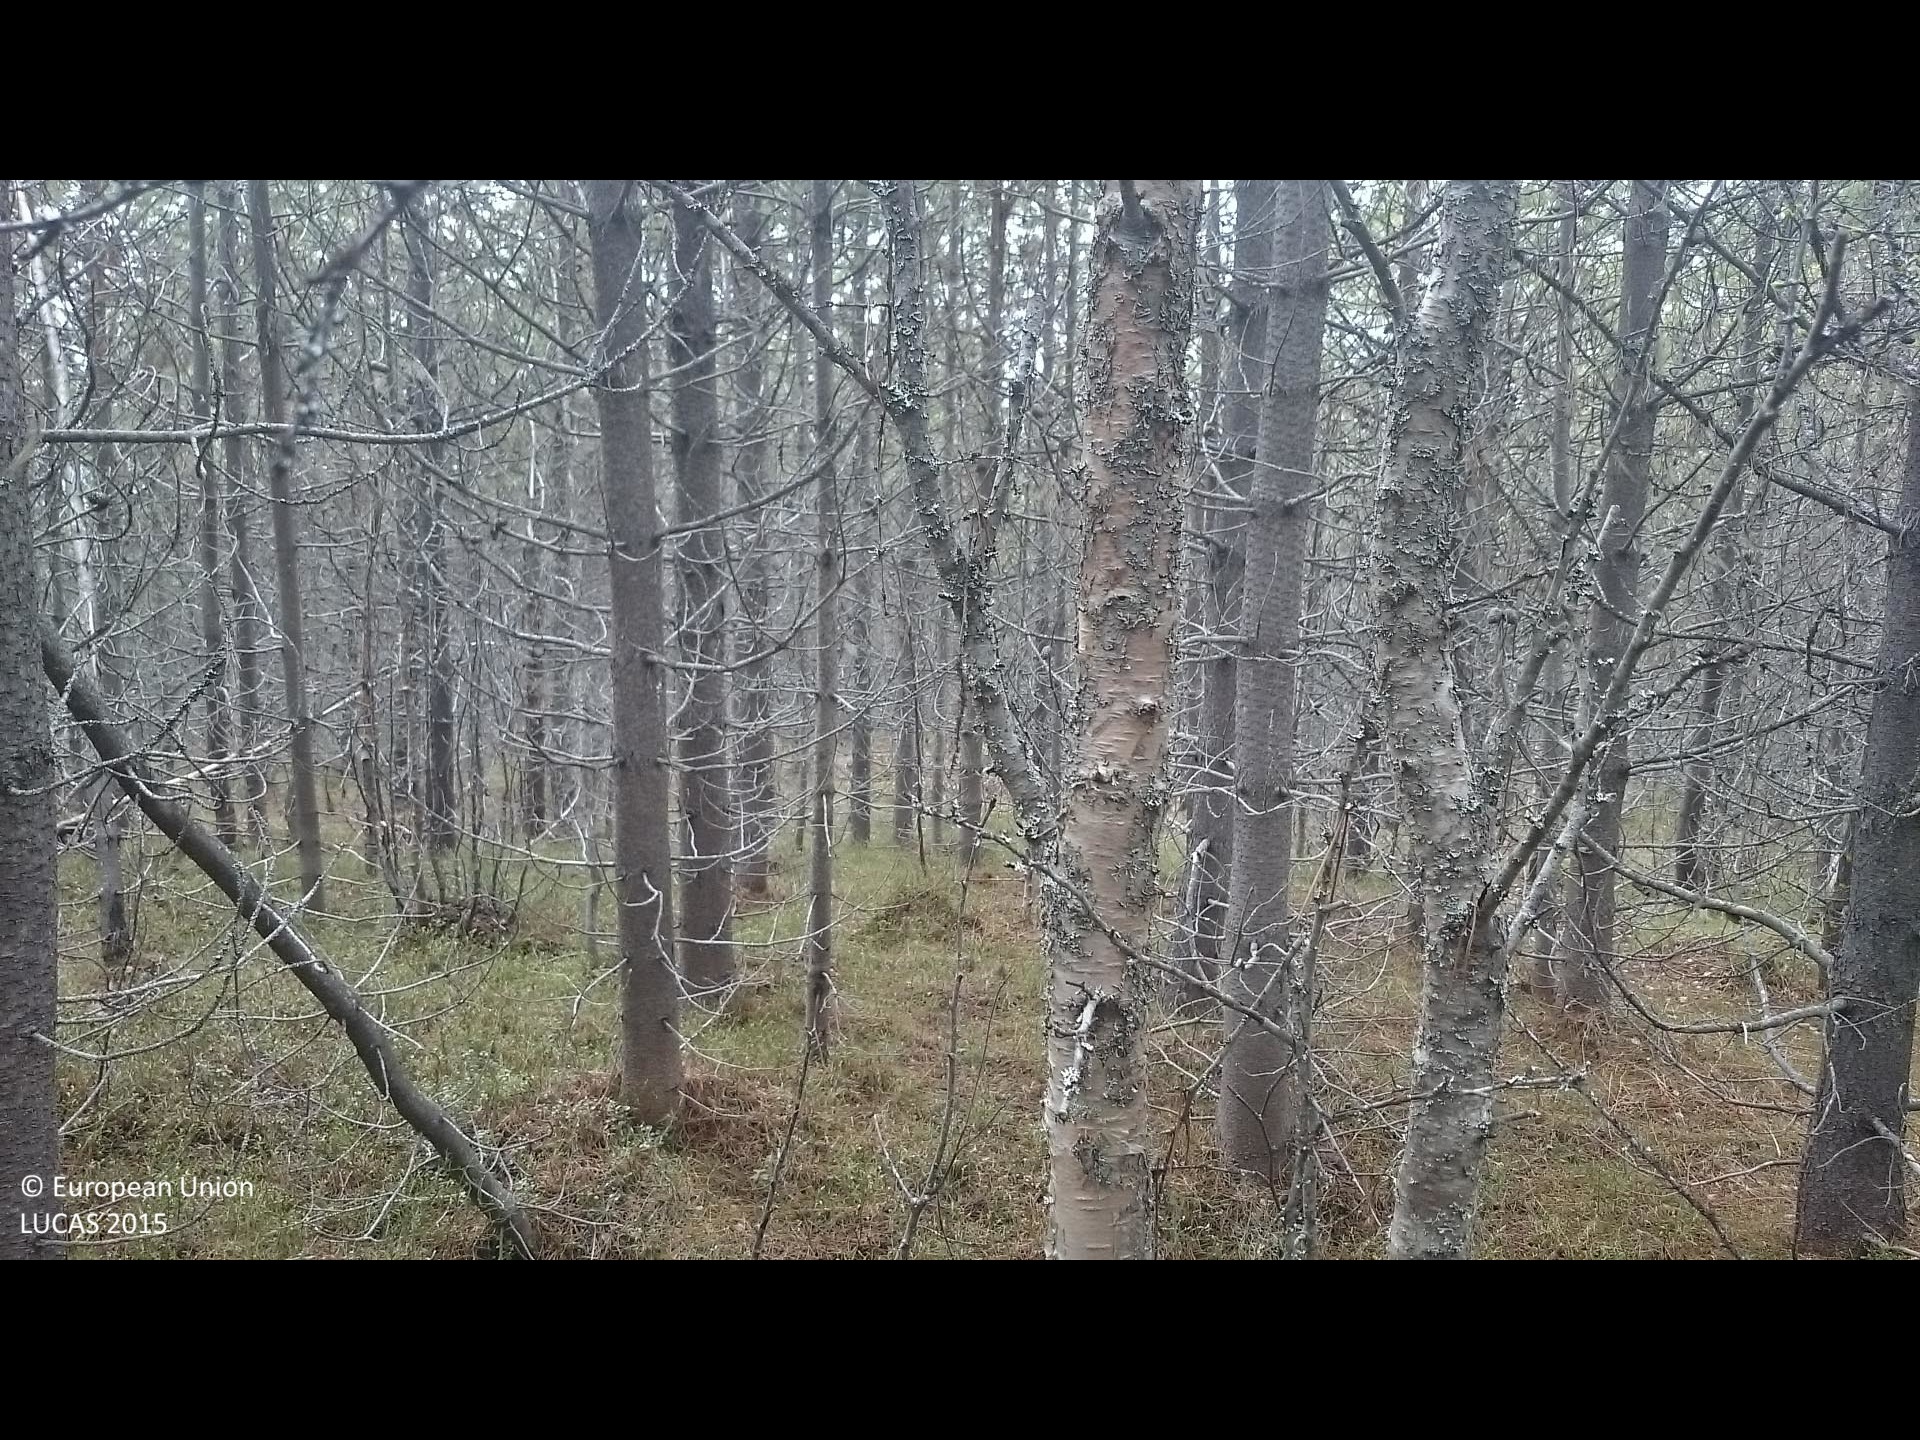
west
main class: Woodland
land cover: Pine dominated coniferous woodland
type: exotic forest
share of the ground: > 75 %
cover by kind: coniferous forest trees 90 %, lichens and mosses 10 %
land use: Forestry
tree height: > 5 m
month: June
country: SE
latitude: 63.7379
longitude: 13.8080
